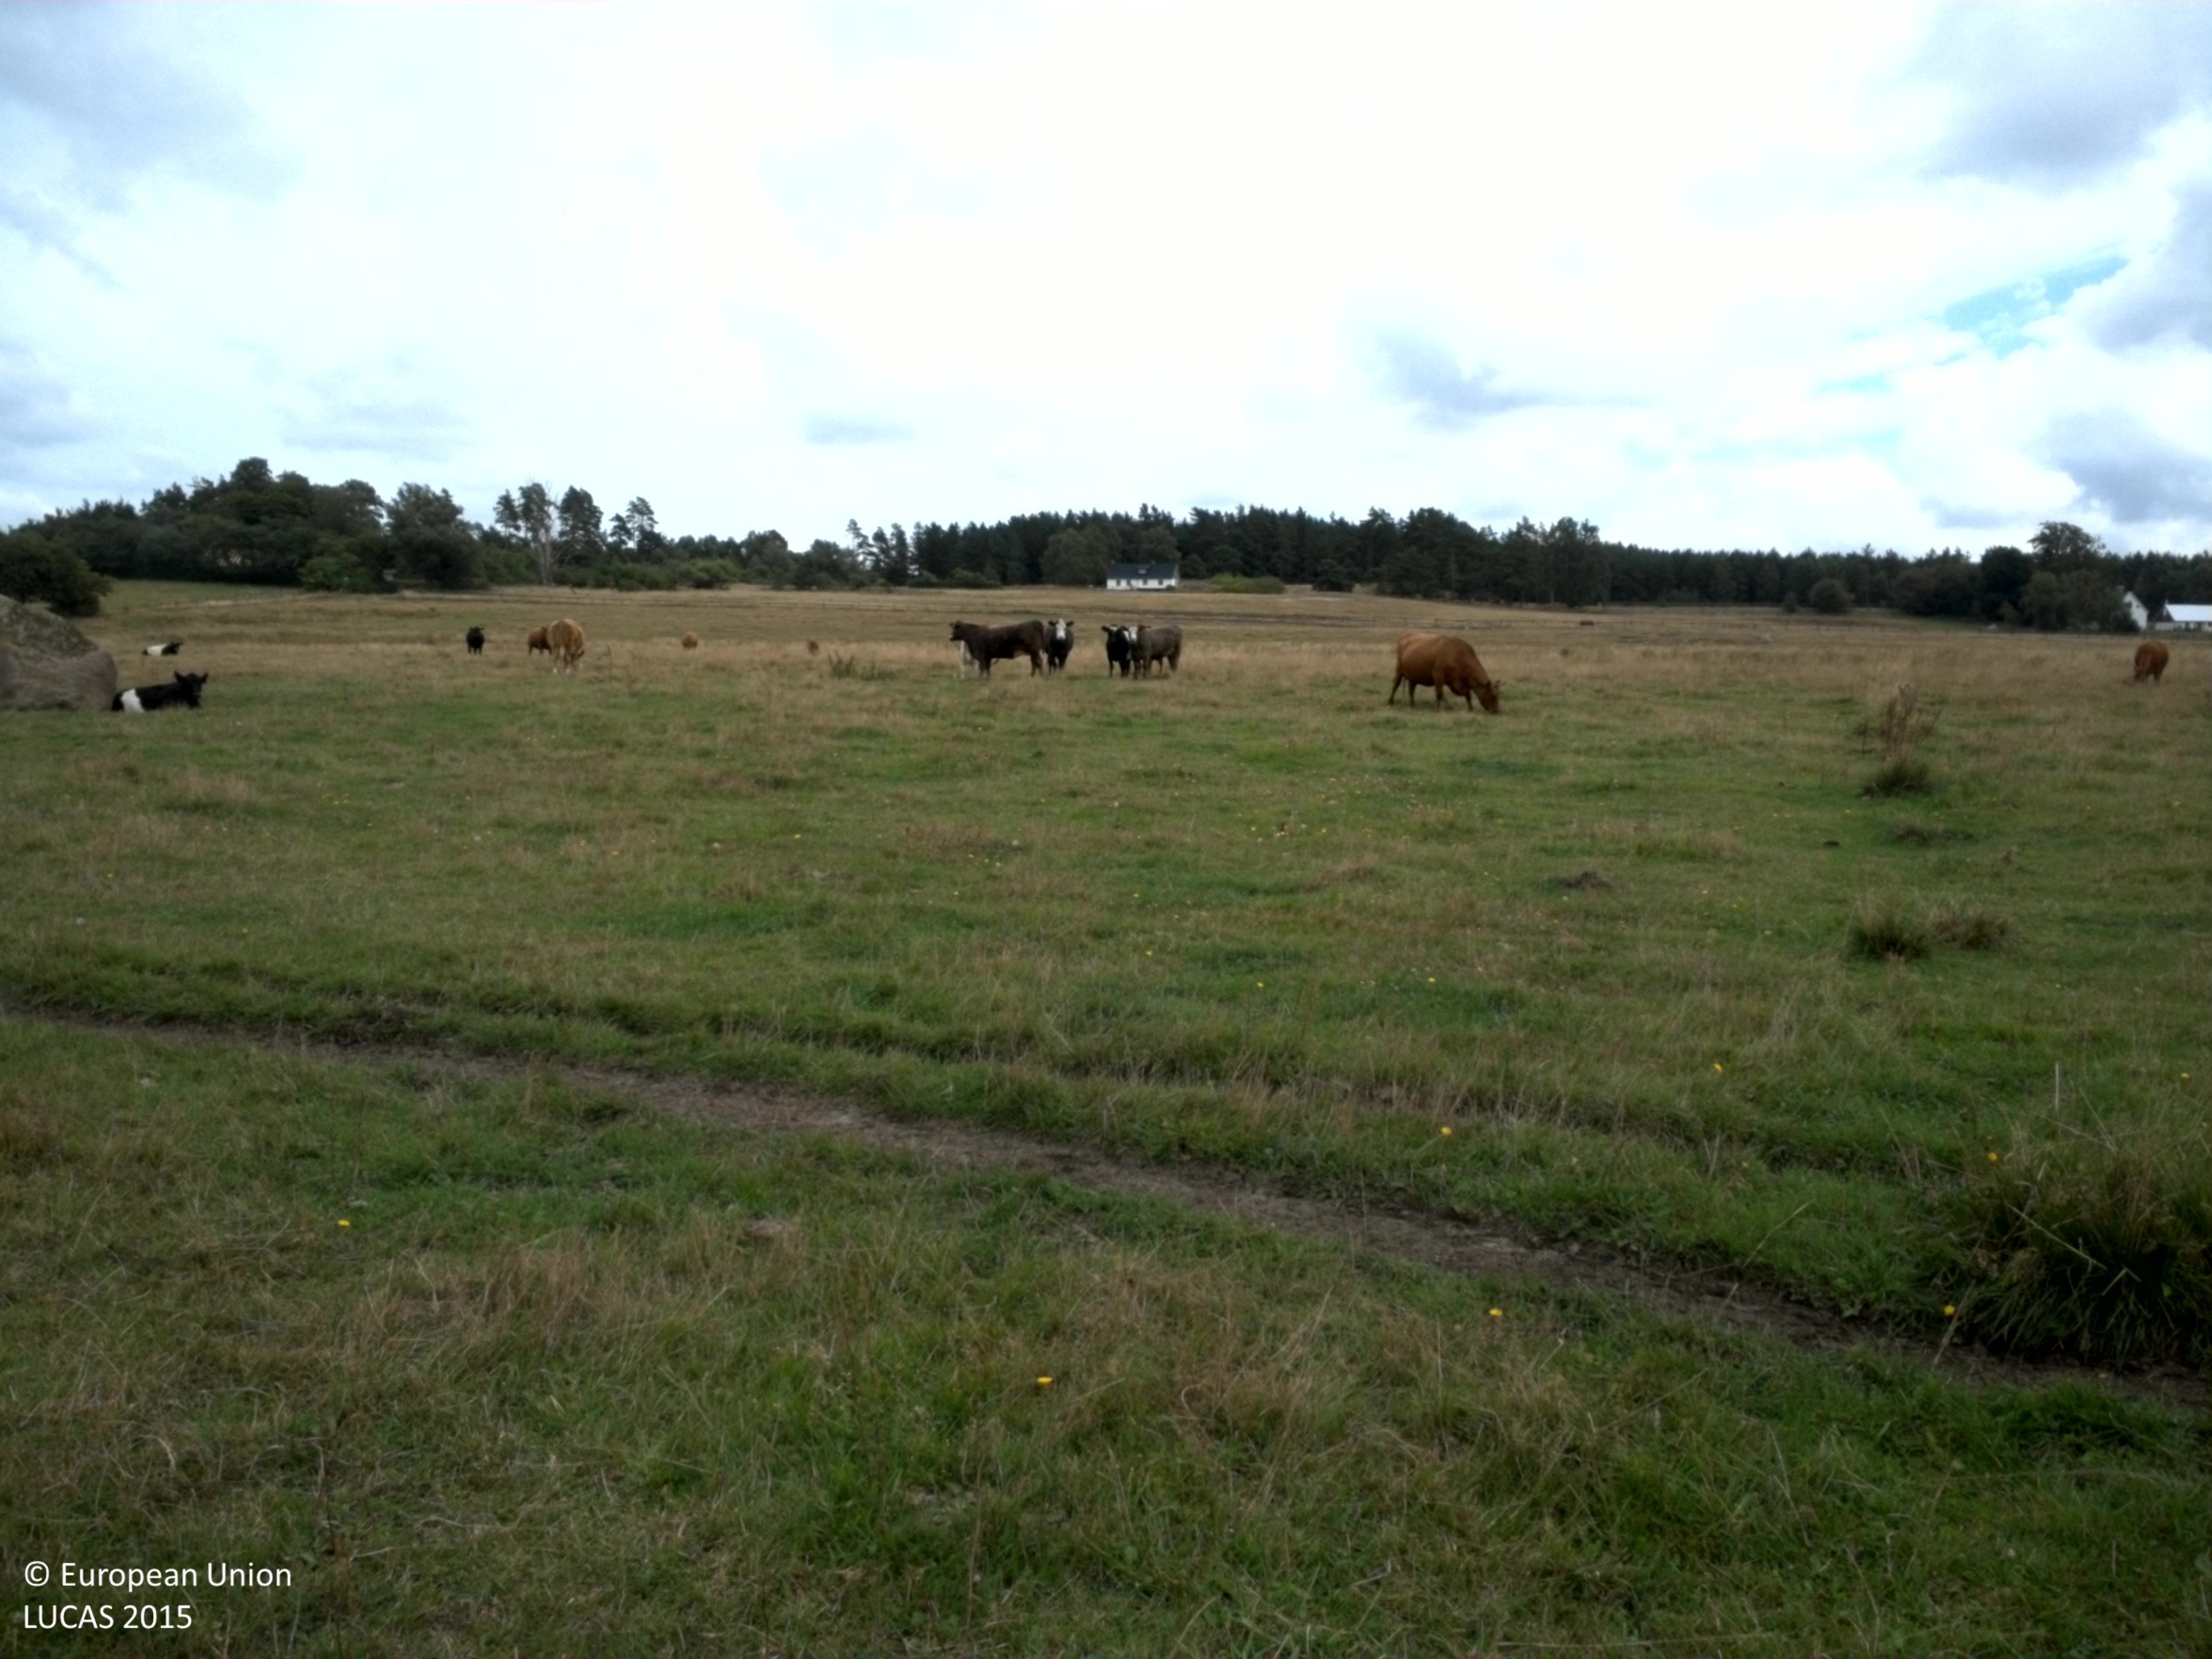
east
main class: Grassland
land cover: Grassland without tree/shrub cover
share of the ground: > 75 %
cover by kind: herbaceous plants 100 %
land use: Agriculture (excluding fallow land and kitchen gardens)
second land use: Amenities, museums, leisure
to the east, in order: Grassland without tree/shrub cover; Fences; Grass margins; Tracks; Grass margins; Fences; Grassland without tree/shrub cover
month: September
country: SE
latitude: 55.5598
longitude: 13.6607
